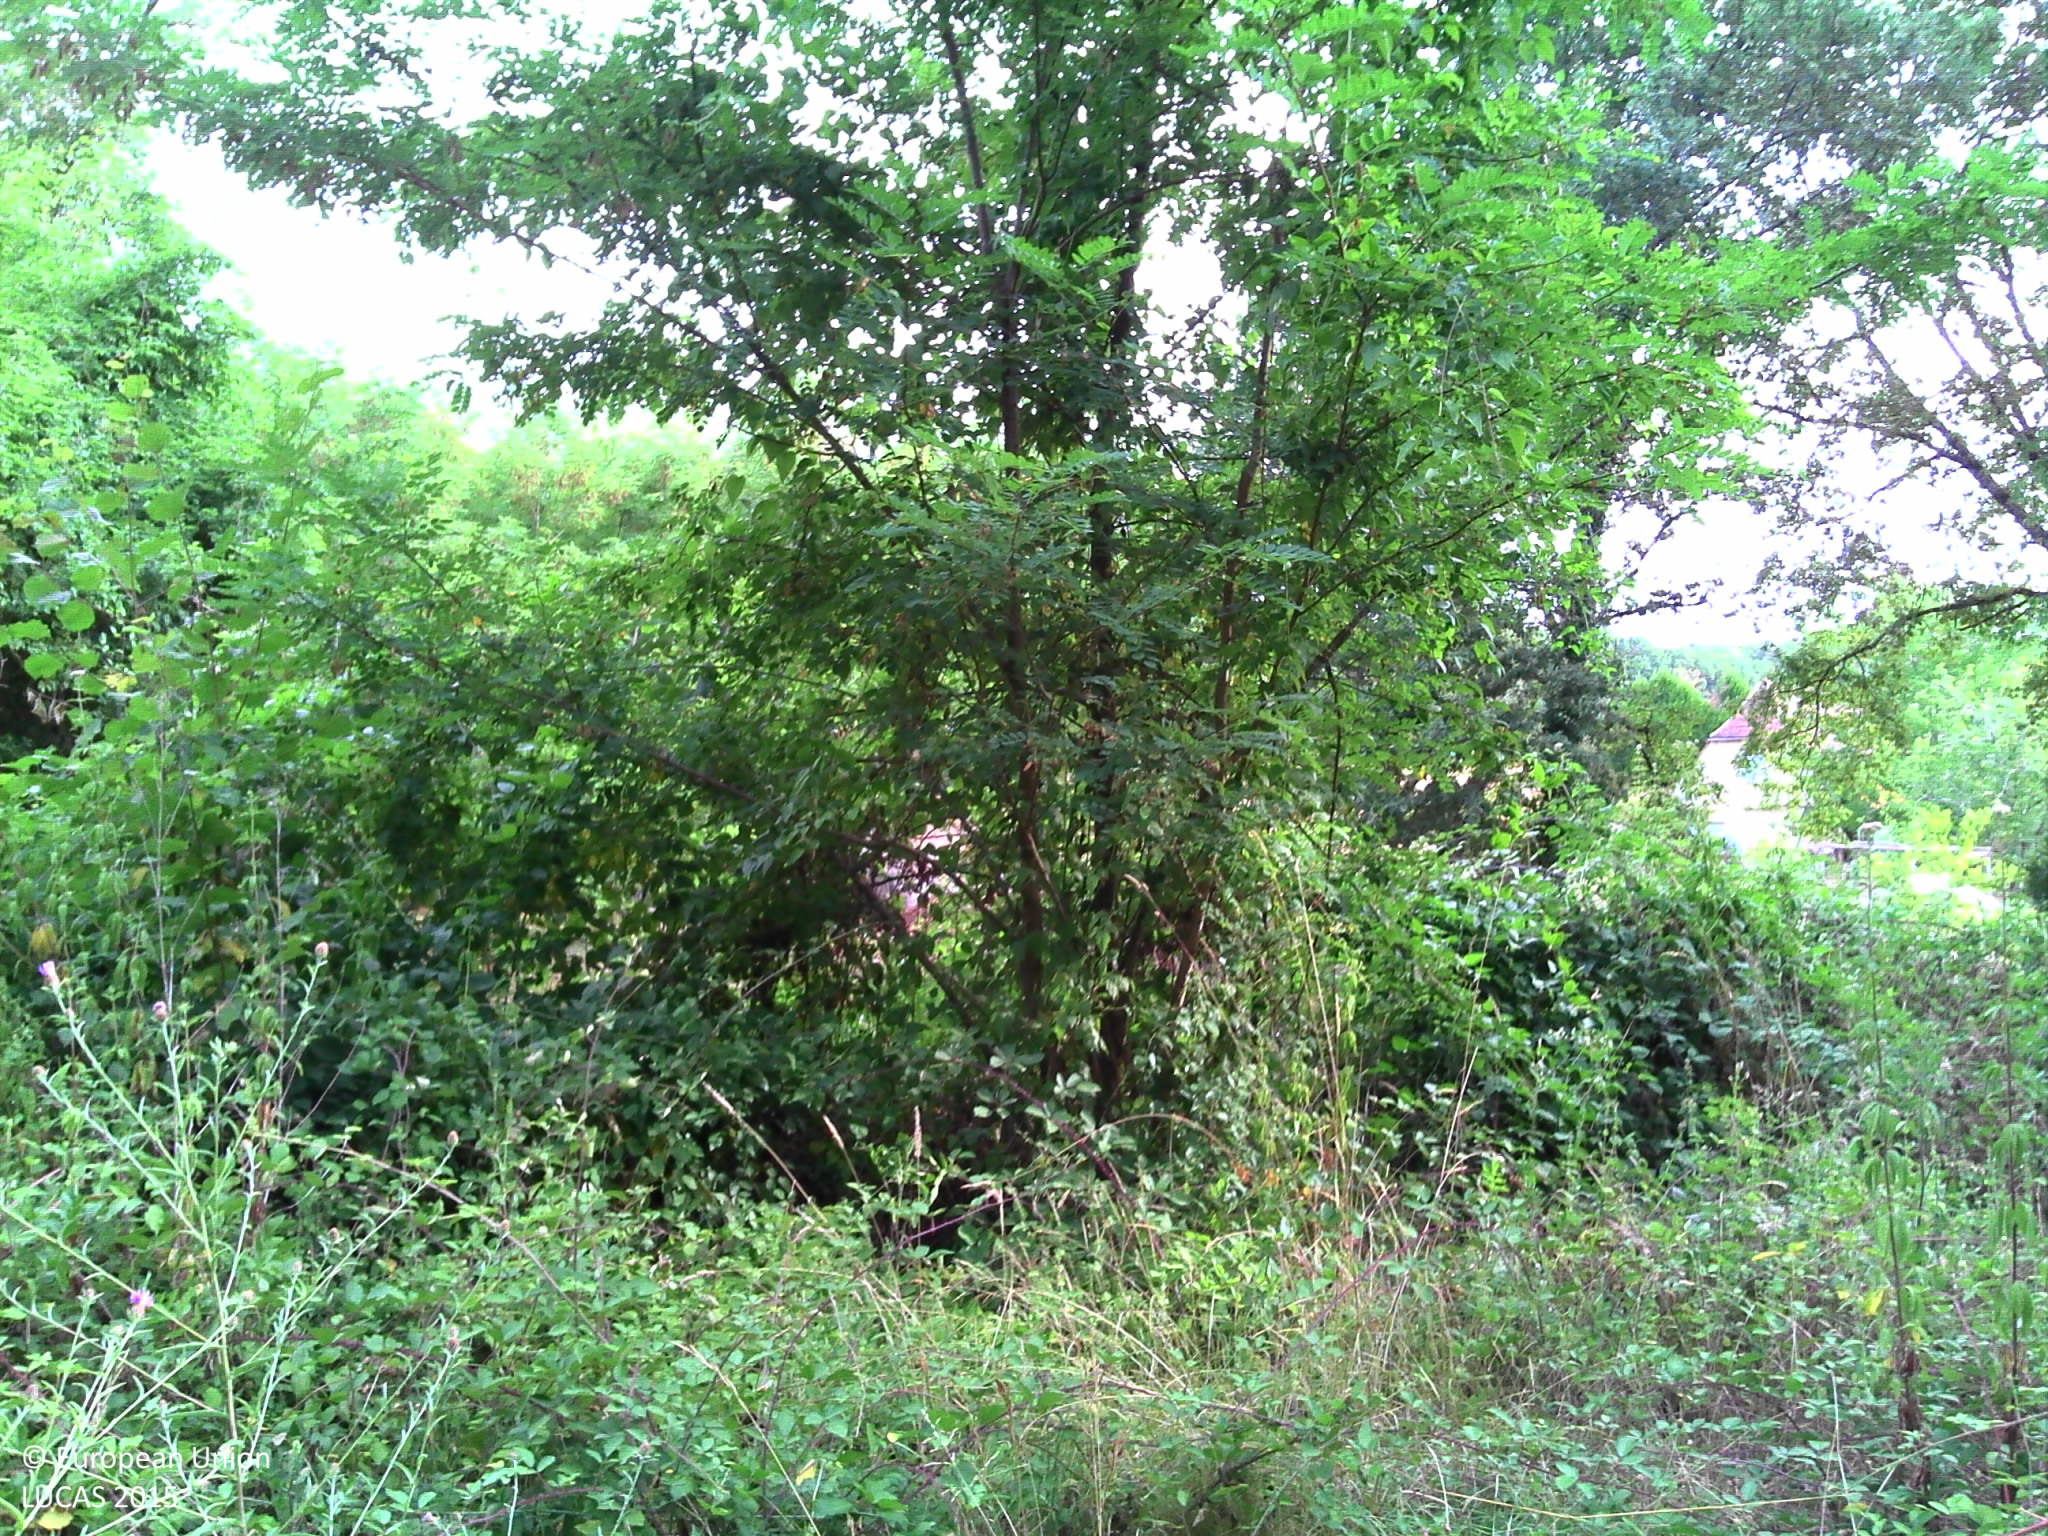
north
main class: Woodland
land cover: Broadleaved woodland
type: thermophilous deciduous forest
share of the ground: > 75 %
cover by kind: broadleaved forest trees 80 %, herbaceous plants 10 %, shrubs 5 %, lichens and mosses 5 %
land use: Residential
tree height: > 5 m
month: July
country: FR
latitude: 44.9570
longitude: 0.8014
